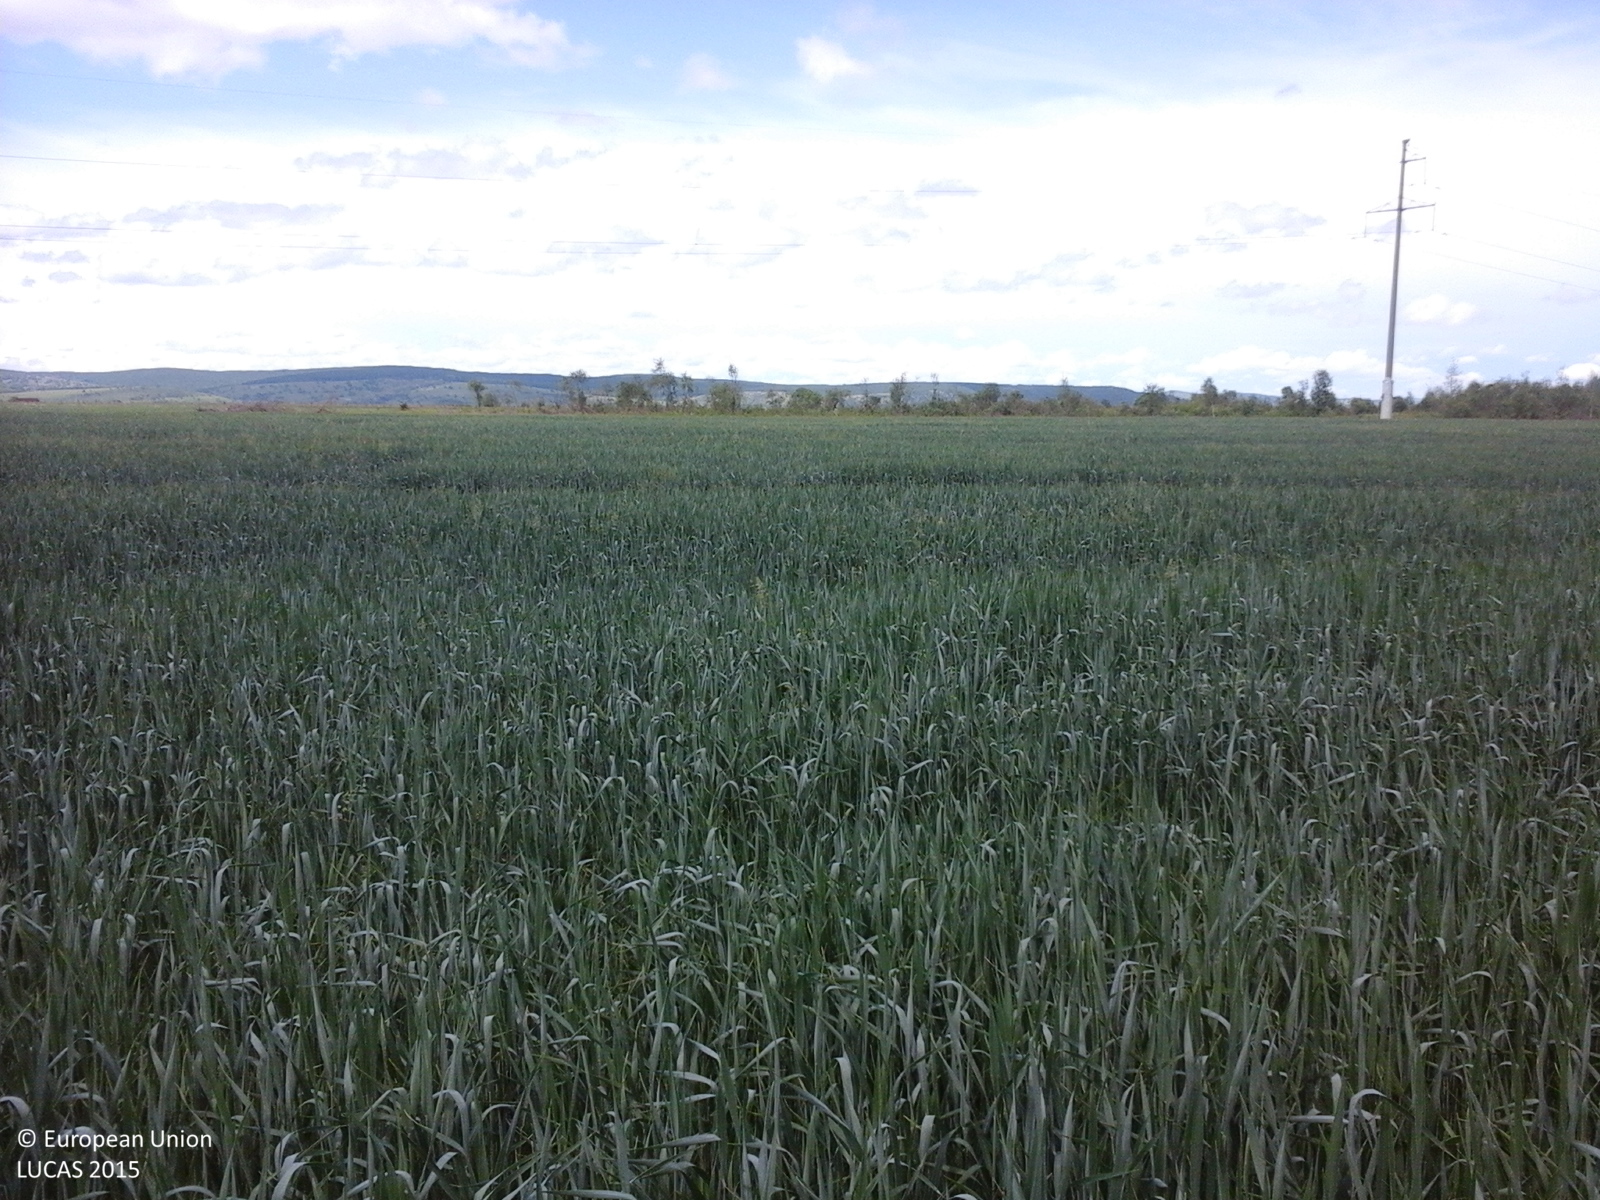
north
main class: Cropland
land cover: Rye
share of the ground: > 75 %
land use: Agriculture (excluding fallow land and kitchen gardens)
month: May
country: RO
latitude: 45.8291
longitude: 25.1702
